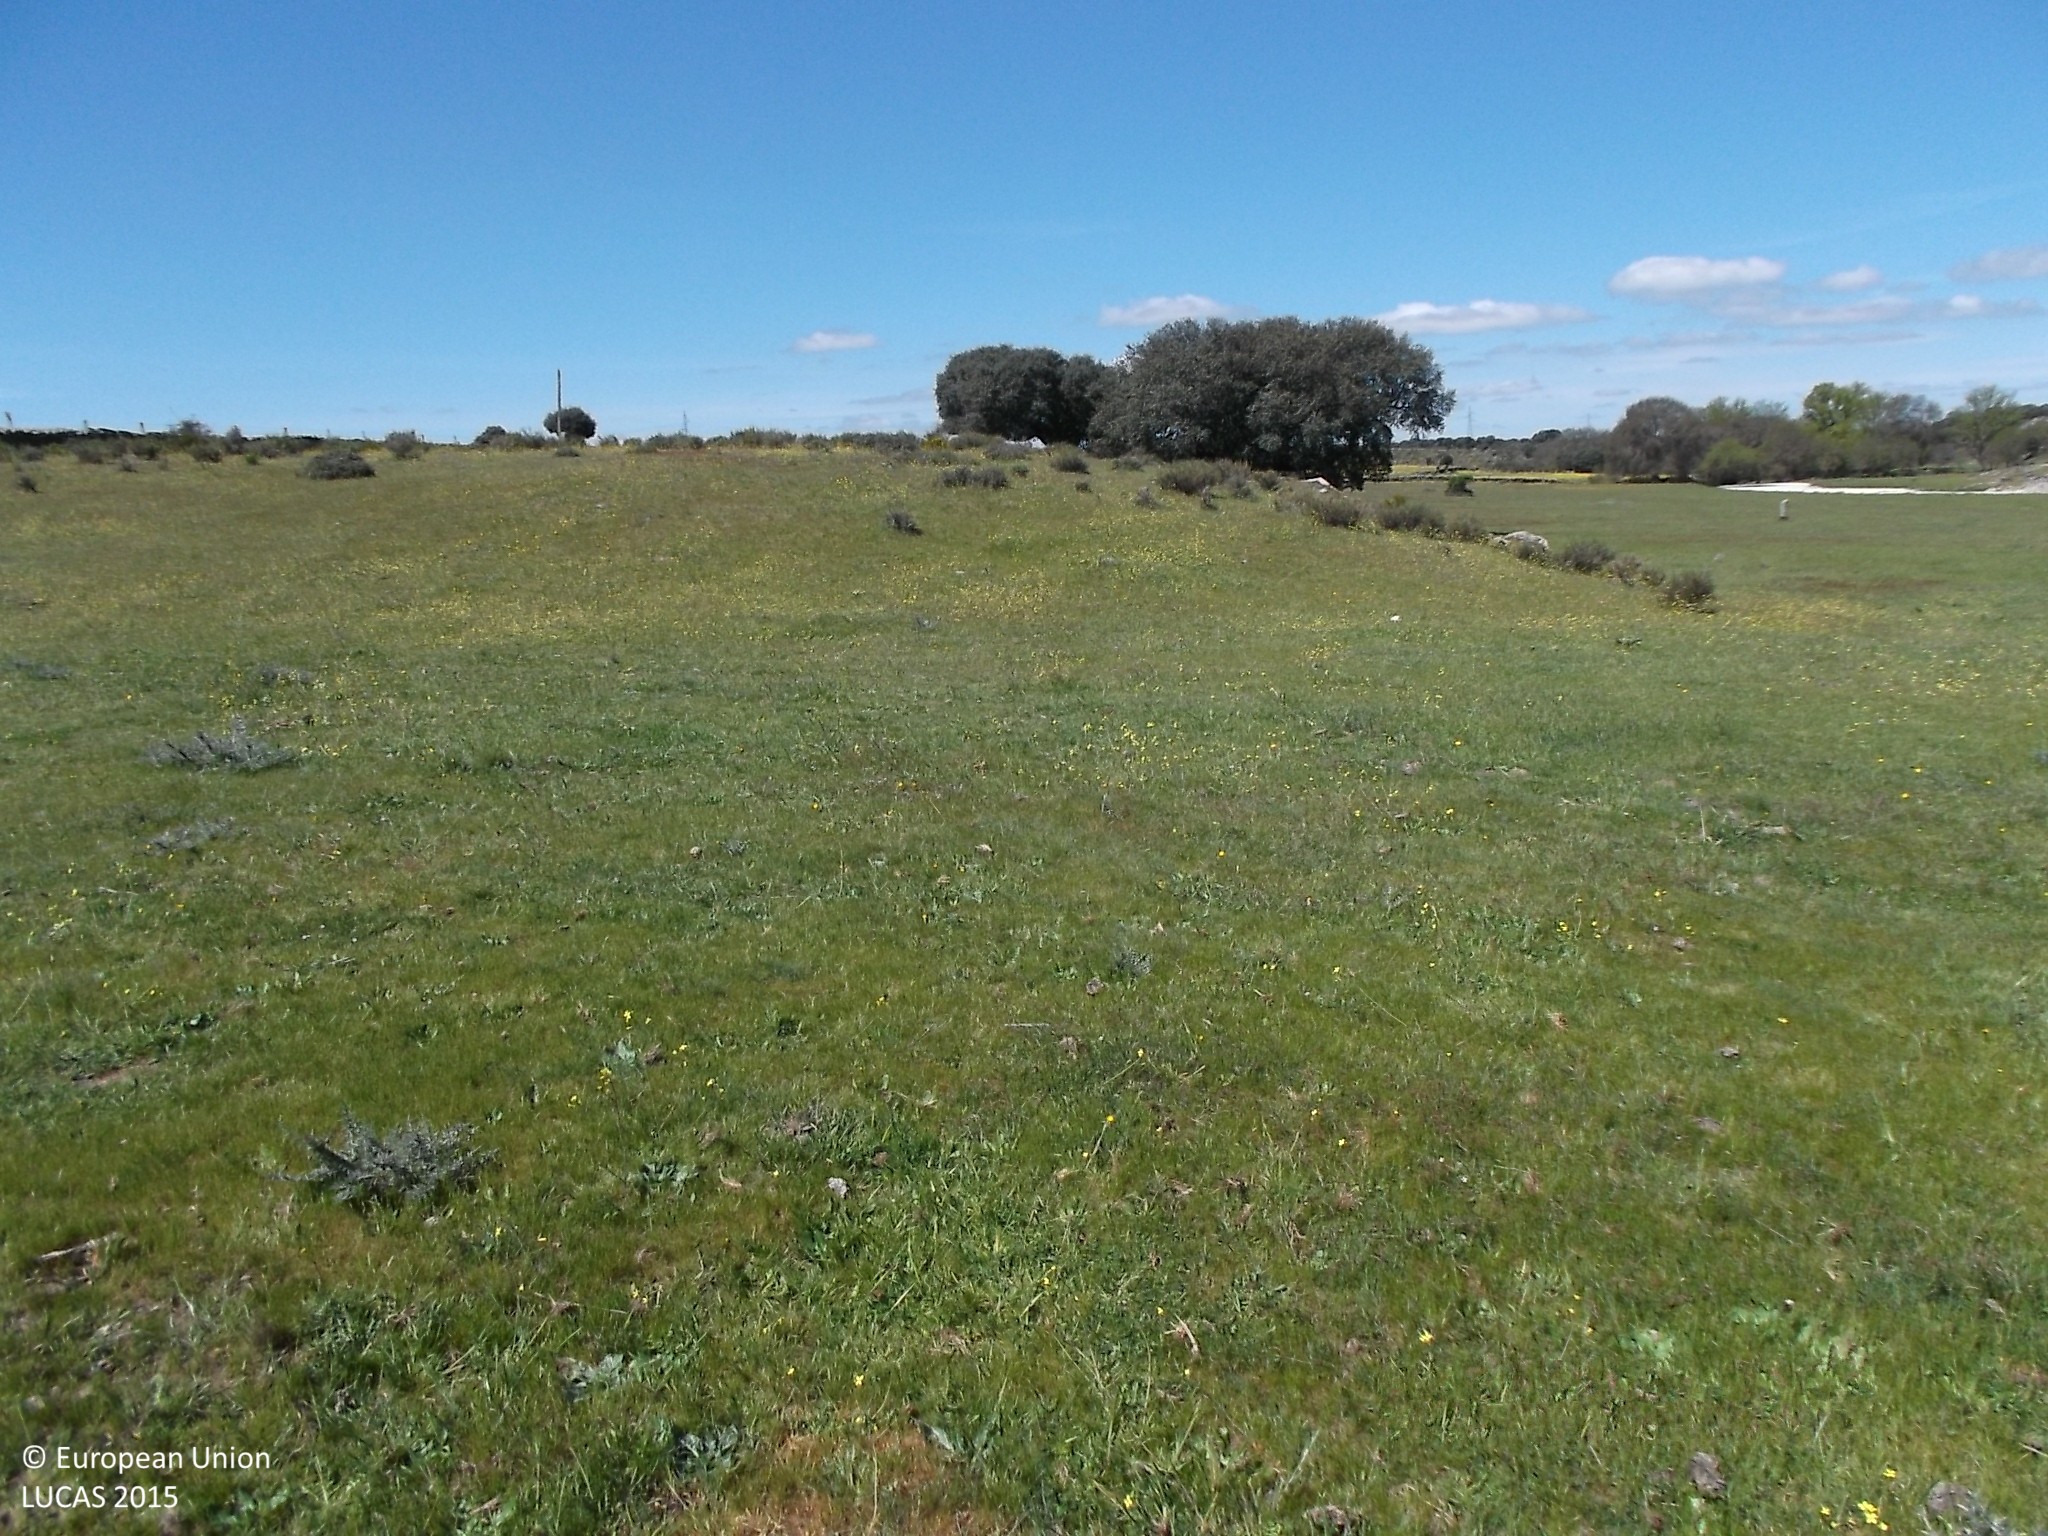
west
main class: Grassland
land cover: Grassland without tree/shrub cover
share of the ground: > 75 %
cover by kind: herbaceous plants 100 %
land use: Agriculture (excluding fallow land and kitchen gardens)
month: April
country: ES
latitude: 41.0508
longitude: -5.9436
